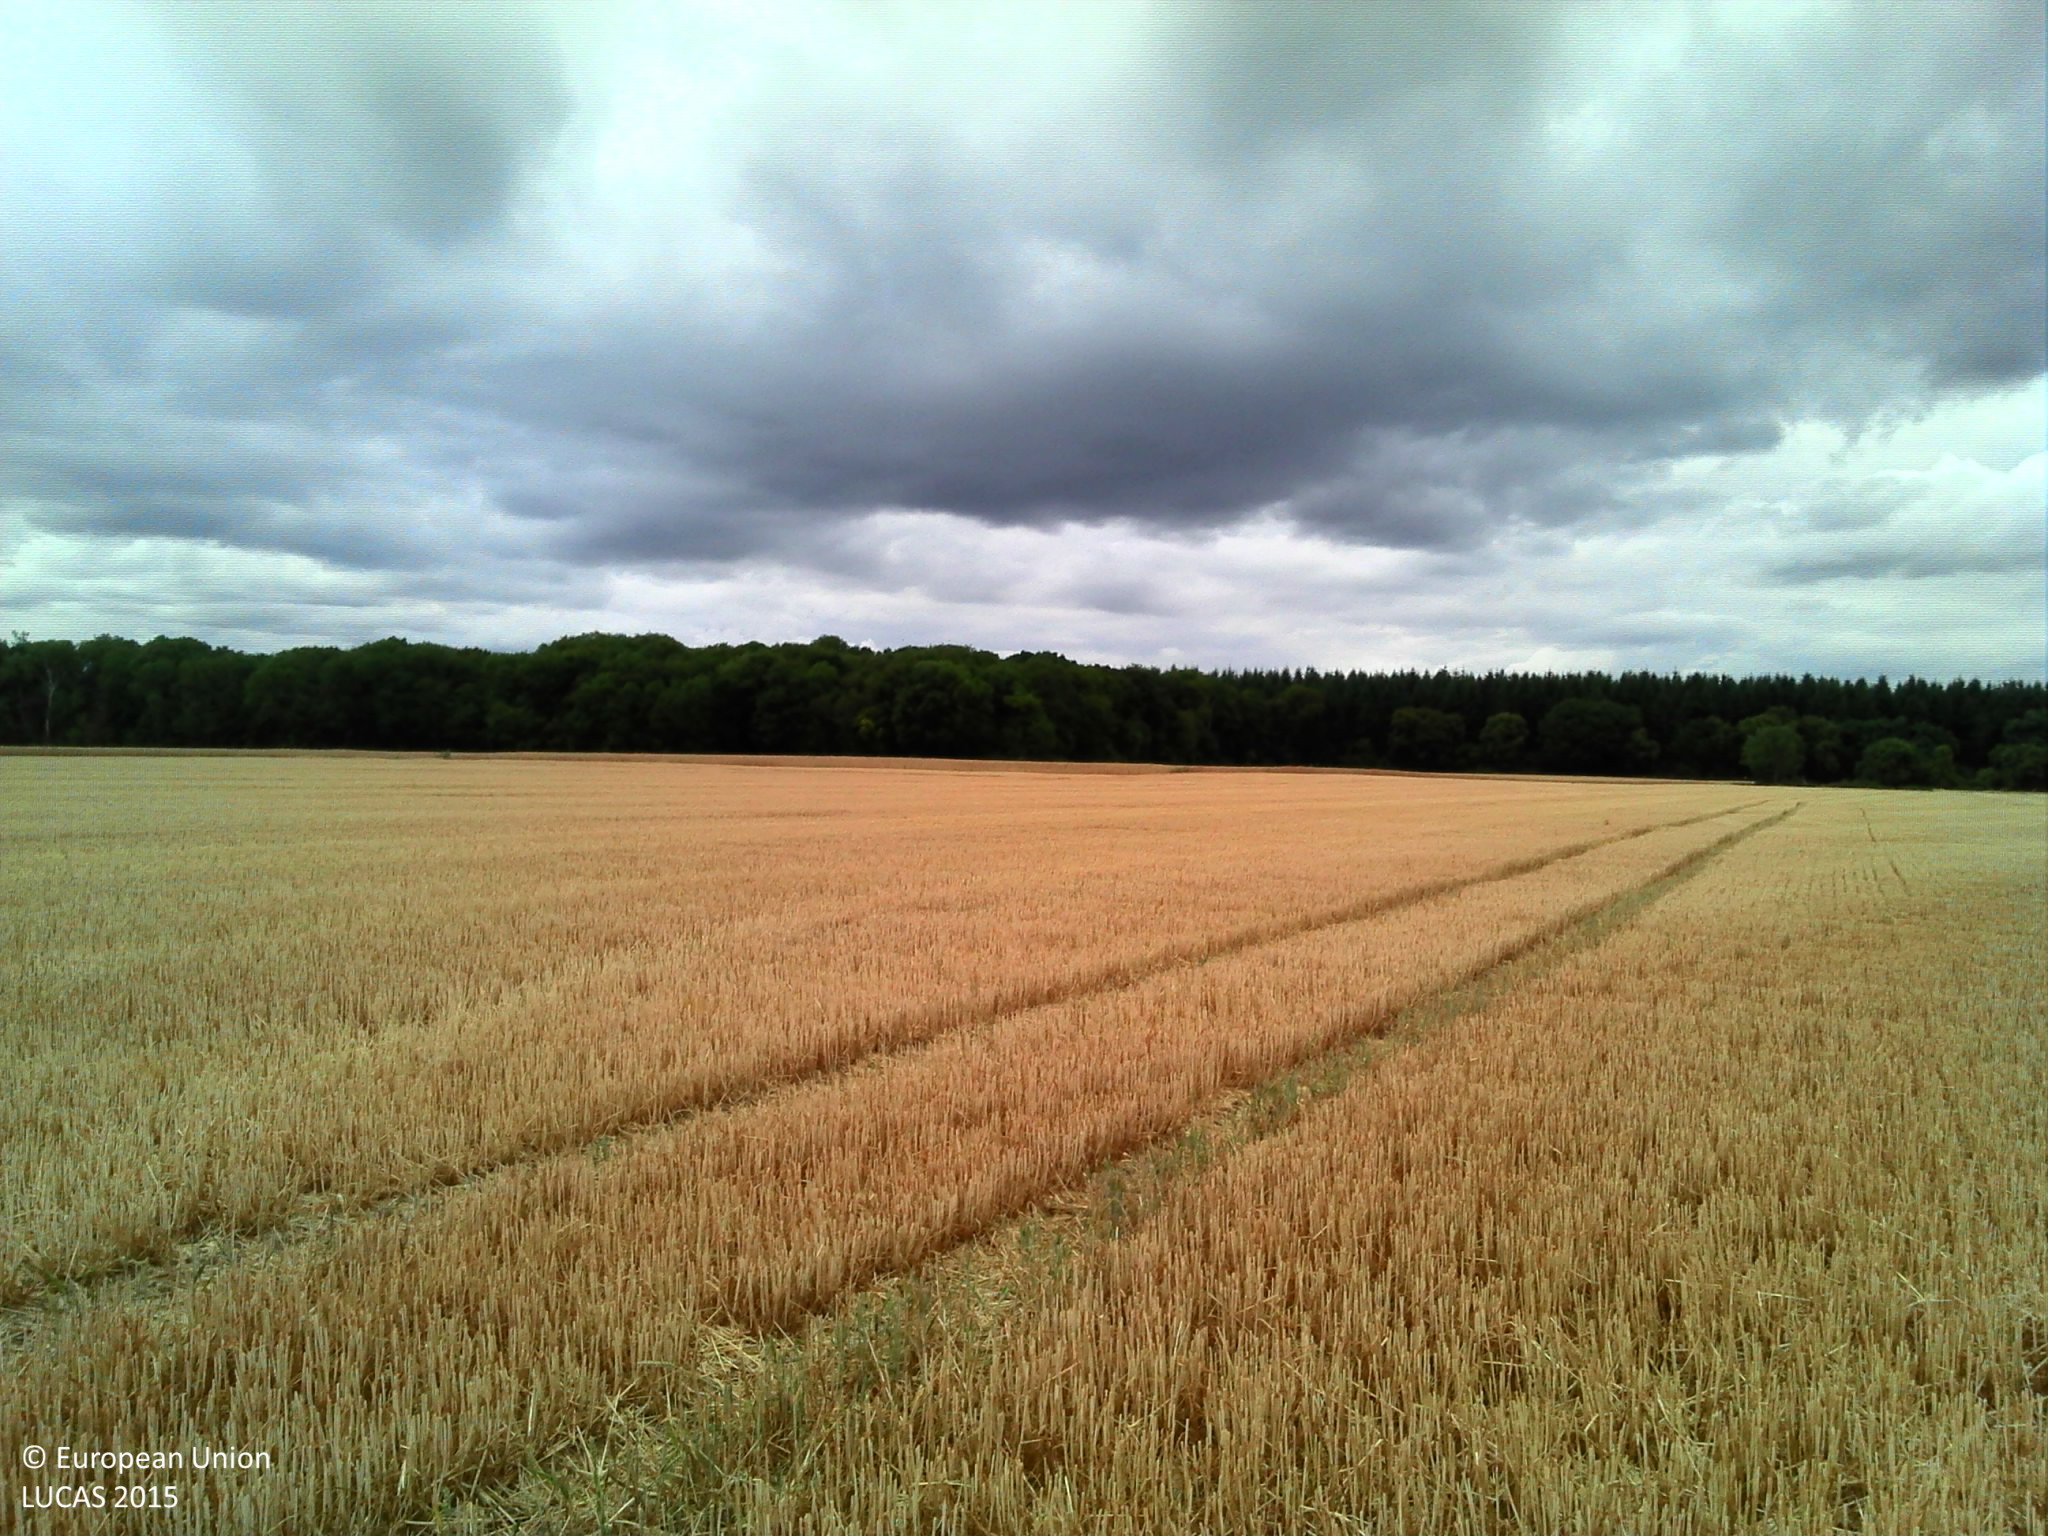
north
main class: Cropland
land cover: Common wheat
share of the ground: > 75 %
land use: Agriculture (excluding fallow land and kitchen gardens)
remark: Harvested field
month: July
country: FR
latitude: 49.1059
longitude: 2.4956
